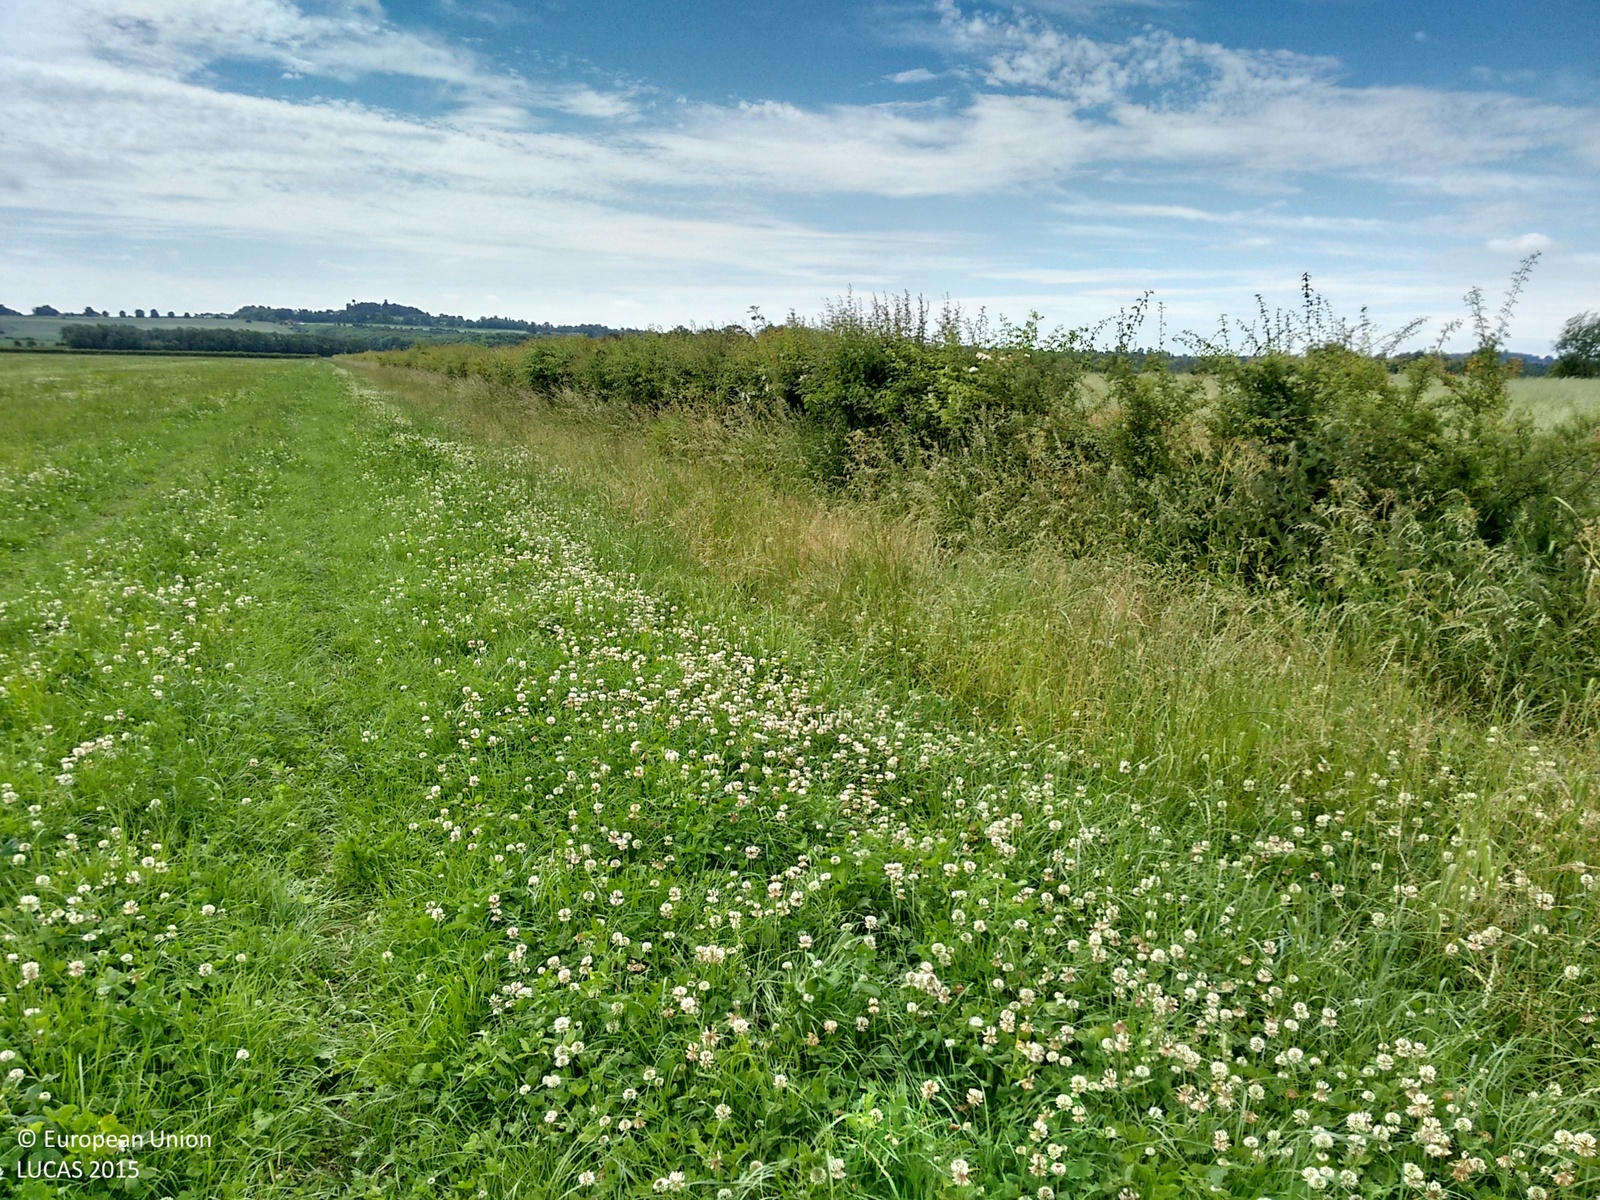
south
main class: Grassland
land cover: Grassland without tree/shrub cover
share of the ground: > 75 %
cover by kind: herbaceous plants 100 %
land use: Agriculture (excluding fallow land and kitchen gardens)
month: June
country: GB
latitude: 51.6814
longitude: -1.5794
